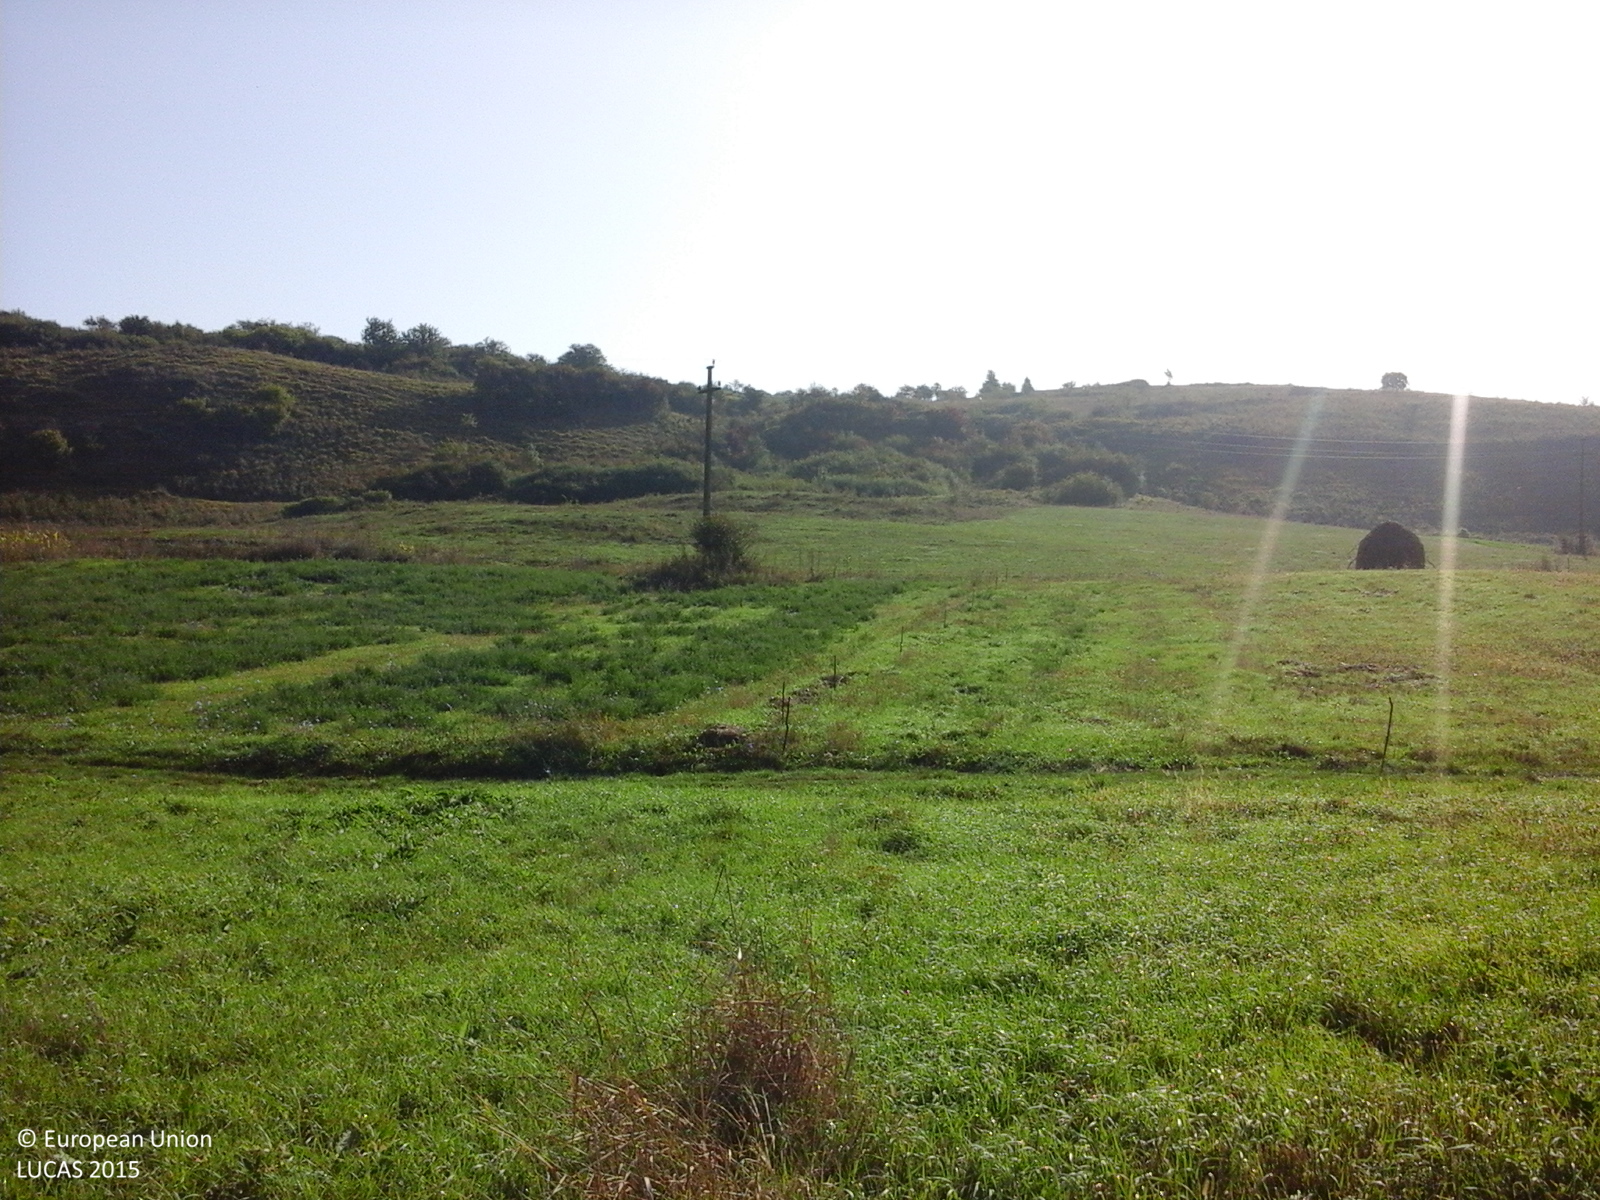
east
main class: Grassland
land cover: Grassland without tree/shrub cover
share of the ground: > 75 %
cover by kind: herbaceous plants 100 %
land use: Agriculture (excluding fallow land and kitchen gardens)
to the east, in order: Grassland without tree/shrub cover; Tracks; Lucerne; Electric lines; Lucerne; Spontaneously vegetated surfaces; Shrubland without tree cover; Grassland with sparse tree/shrub cover; Shrubland without tree cover
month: September
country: RO
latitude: 47.0673
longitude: 23.7303
